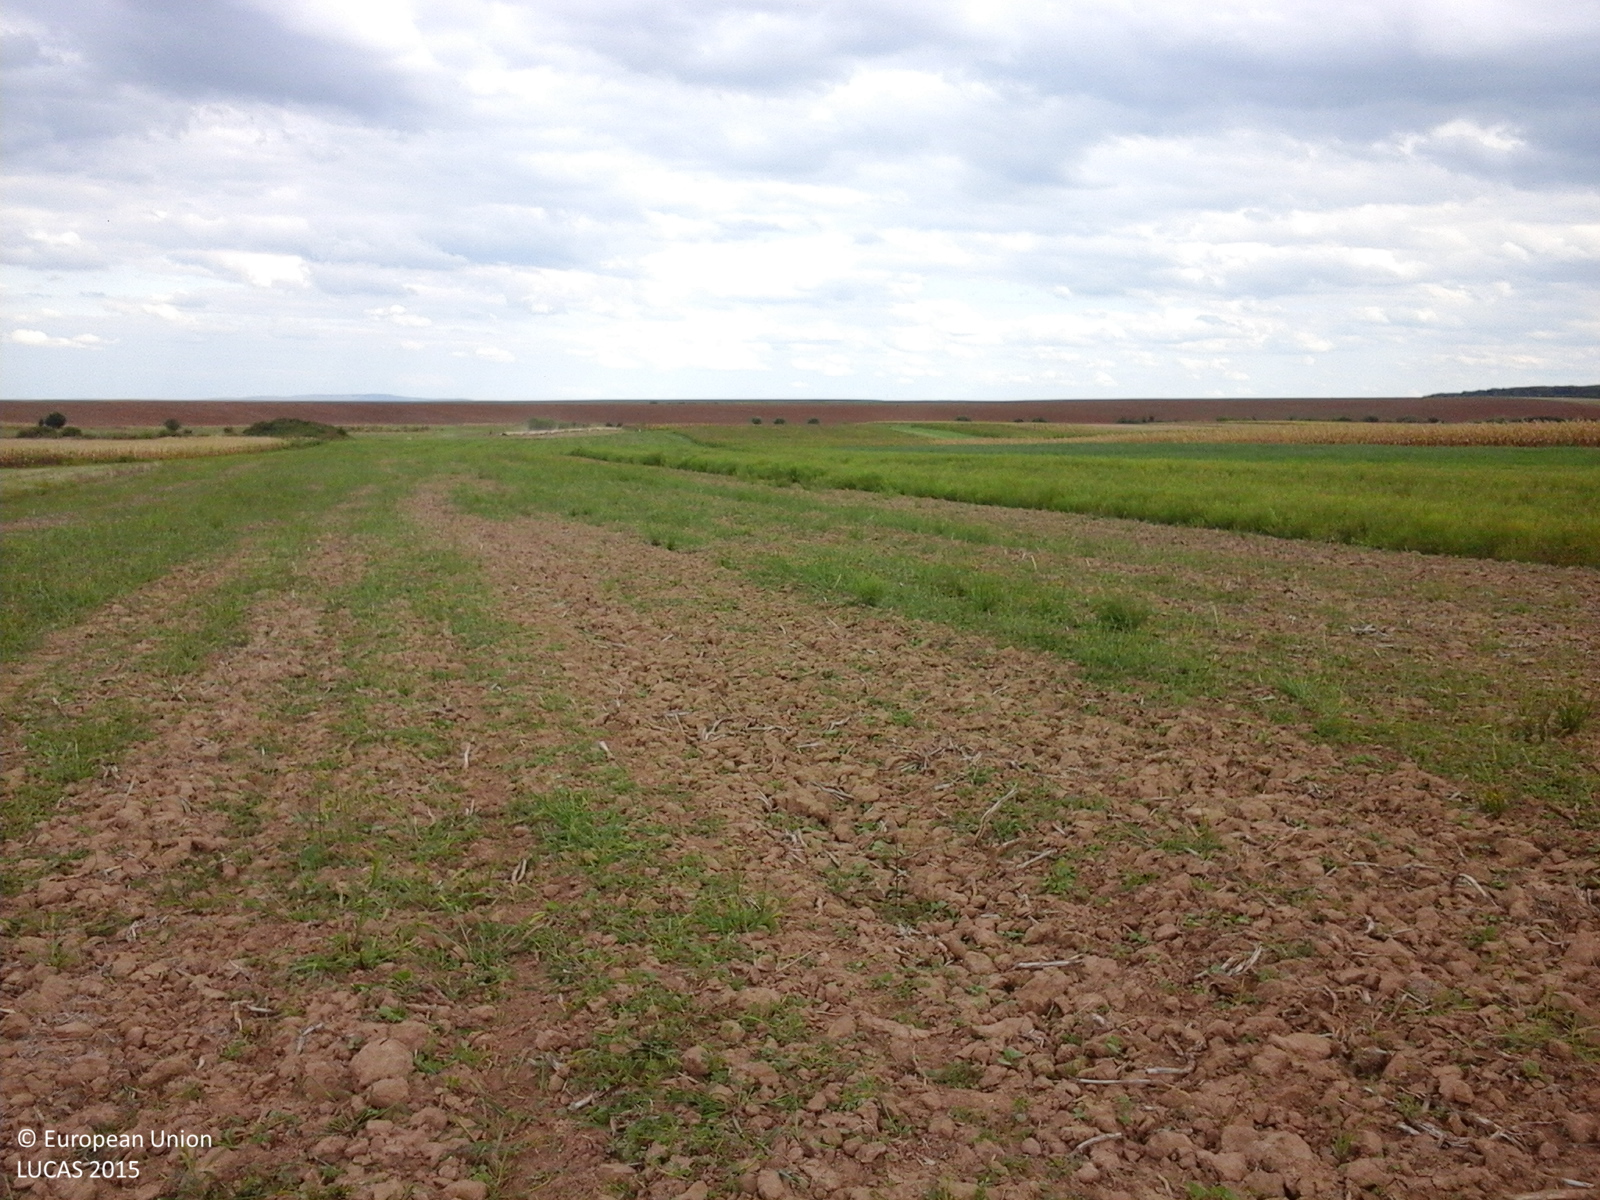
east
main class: Cropland
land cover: Rape and turnip rape
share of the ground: 10 - 25 %
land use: Agriculture (excluding fallow land and kitchen gardens)
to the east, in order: Rape and turnip rape; Grassland with sparse tree/shrub cover; Tracks; Spontaneously vegetated surfaces
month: September
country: RO
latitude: 47.4938
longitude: 22.6291
